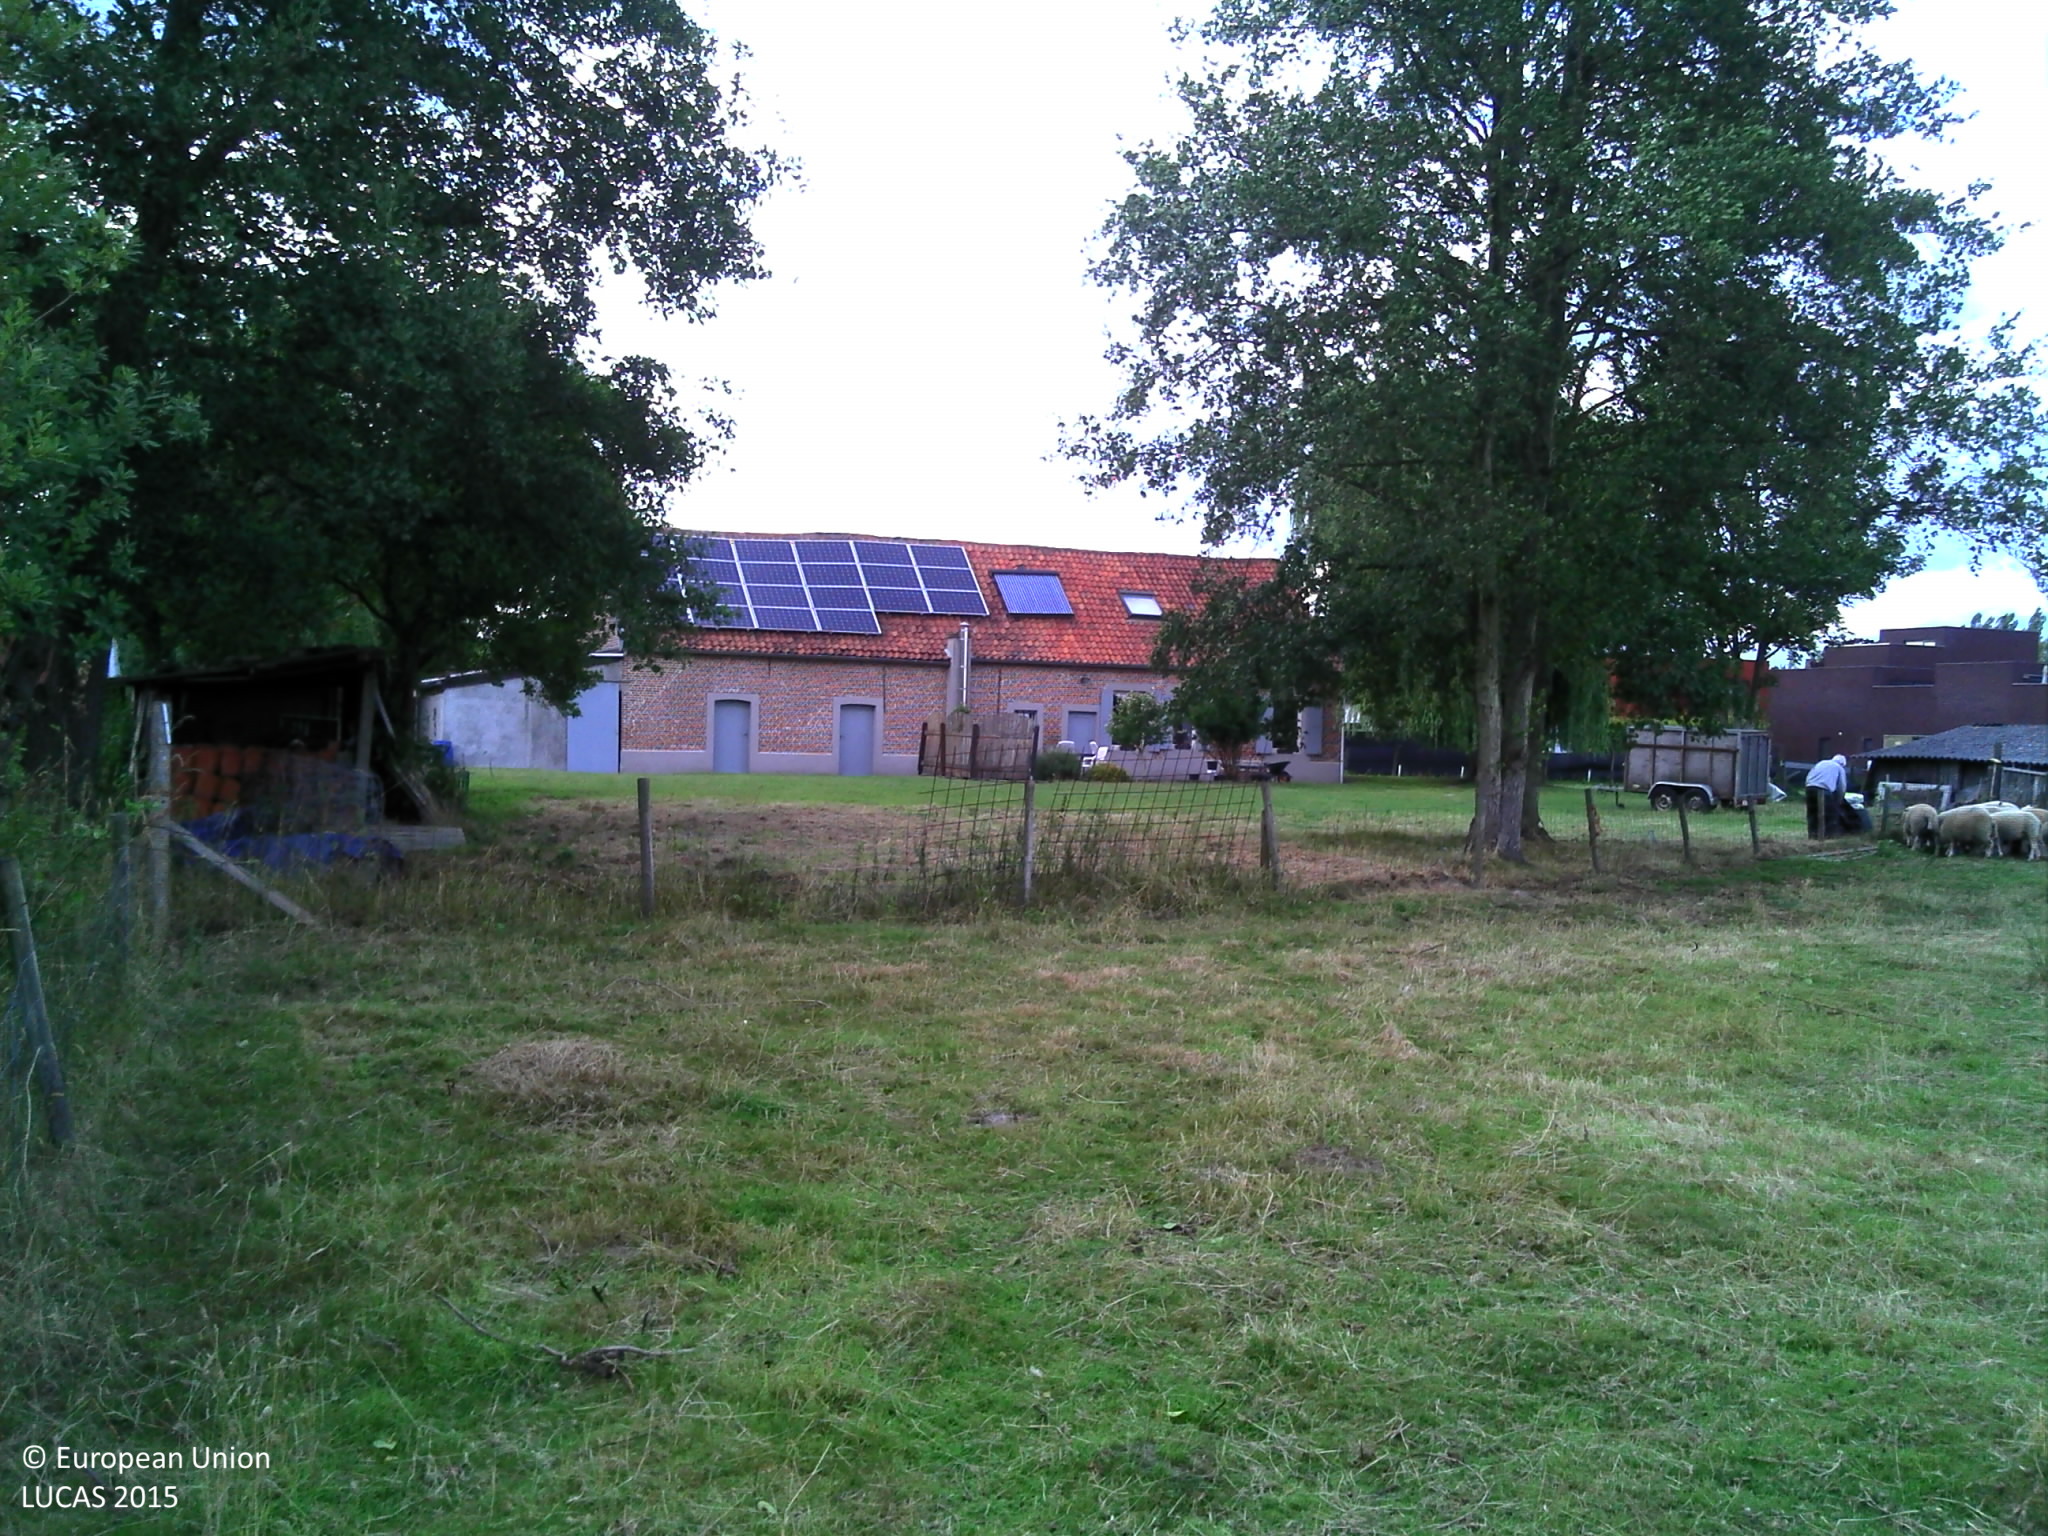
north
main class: Woodland
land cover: Broadleaved woodland
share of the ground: > 75 %
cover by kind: broadleaved forest trees 80 %, coniferous forest trees 10 %, shrubs 10 %
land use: Semi-natural and natural areas not in use
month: July
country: BE
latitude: 51.0622
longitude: 4.5309
